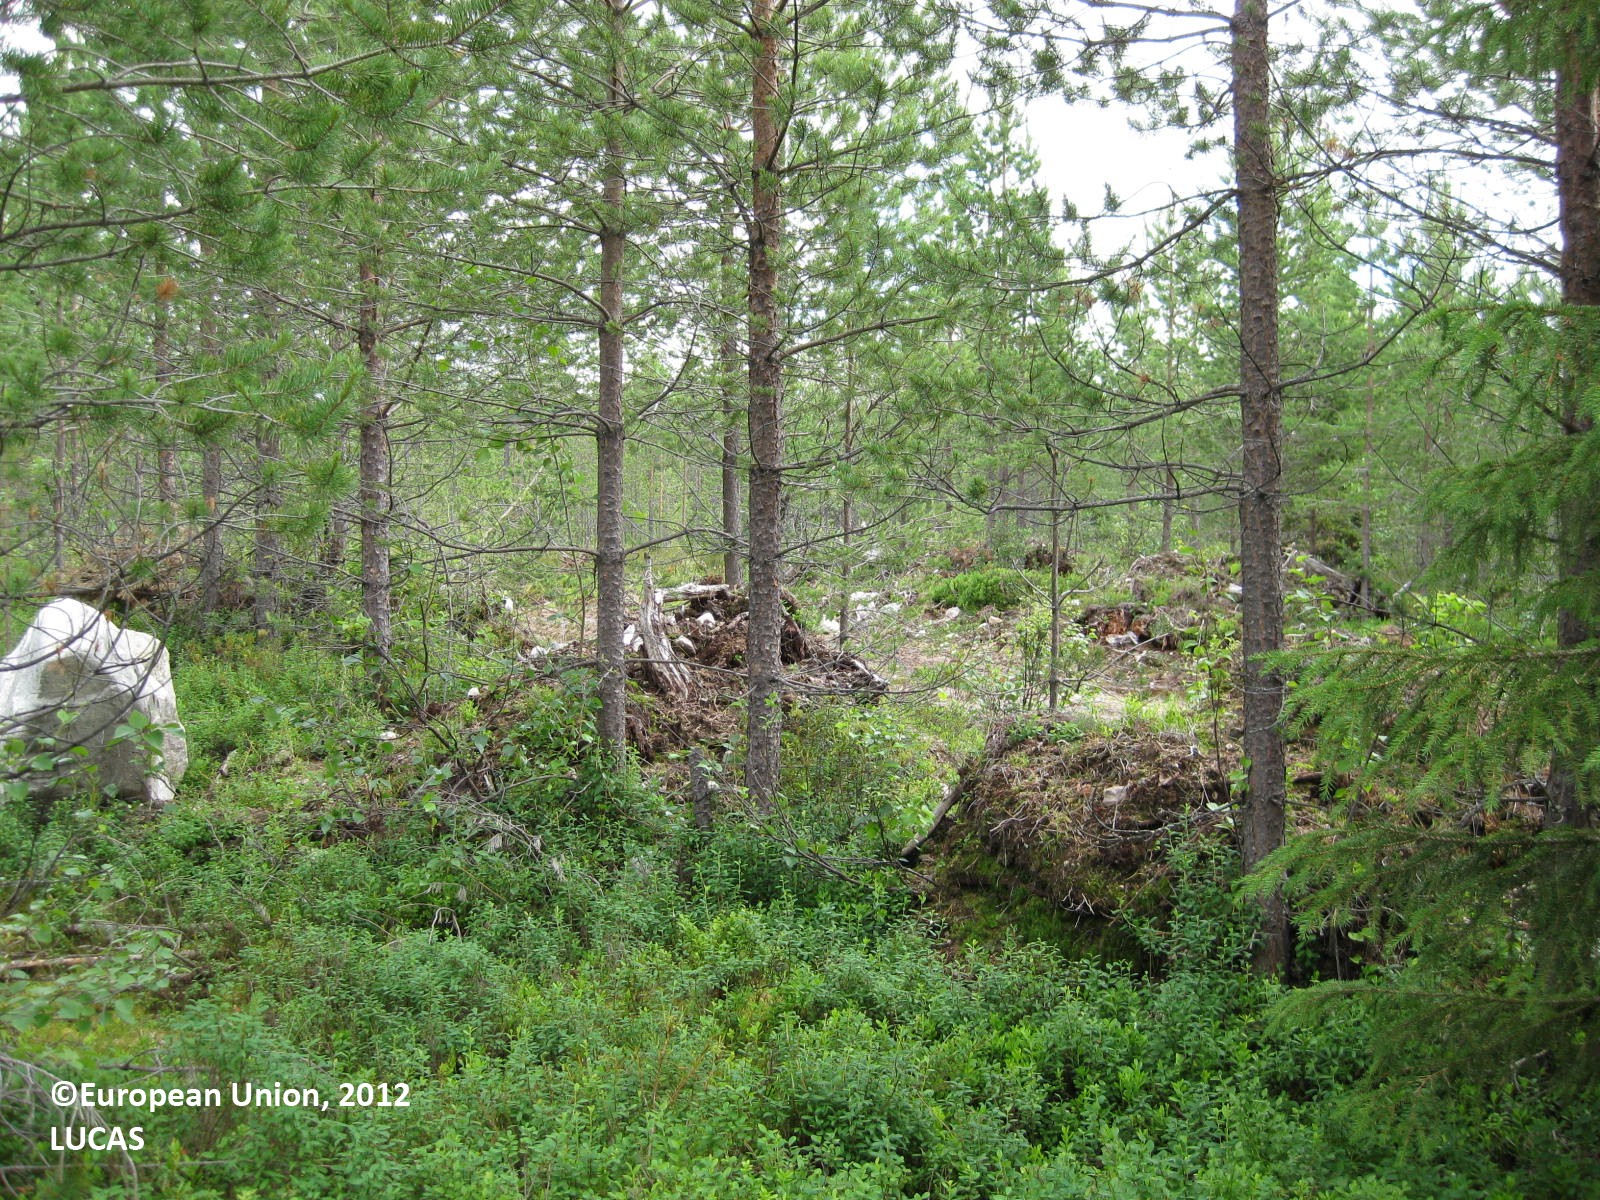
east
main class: Woodland
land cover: Pine dominated coniferous woodland
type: boreal forest
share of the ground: > 75 %
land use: Forestry
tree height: > 5 m
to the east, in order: Pine dominated coniferous woodland; Ditches and canals; Tracks; Pine dominated coniferous woodland; Peatbogs; Pine dominated coniferous woodland; Ditches and canals; Pine dominated coniferous woodland; Ditches and canals; Pine dominated coniferous woodland; Ditches and canals; Pine dominated coniferous woodland; Ditches and canals; Pine dominated coniferous woodland; Ditches and canals; Pine dominated coniferous woodland; Ditches and canals; Pine dominated coniferous woodland; Ditches and canals; Pine dominated coniferous woodland; Ditches and canals; Pine dominated coniferous woodland; Ditches and canals; Pine dominated coniferous woodland; Ditches and canals; Pine dominated coniferous woodland; Ditches and canals; Pine dominated coniferous woodland; Ditches and canals; Pine dominated coniferous woodland; Ditches and canals; Pine dominated coniferous woodland; Ditches and canals; Pine dominated coniferous woodland; Ditches and canals; Pine dominated coniferous woodland; Ditches and canals; Pine dominated coniferous woodland; Ditches and canals; Pine dominated coniferous woodland; Ditches and canals; Pine dominated coniferous woodland; Ditches and canals; Pine dominated coniferous woodland; Ditches and canals; Pine dominated coniferous woodland
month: July
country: FI
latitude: 65.6555
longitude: 29.2529
